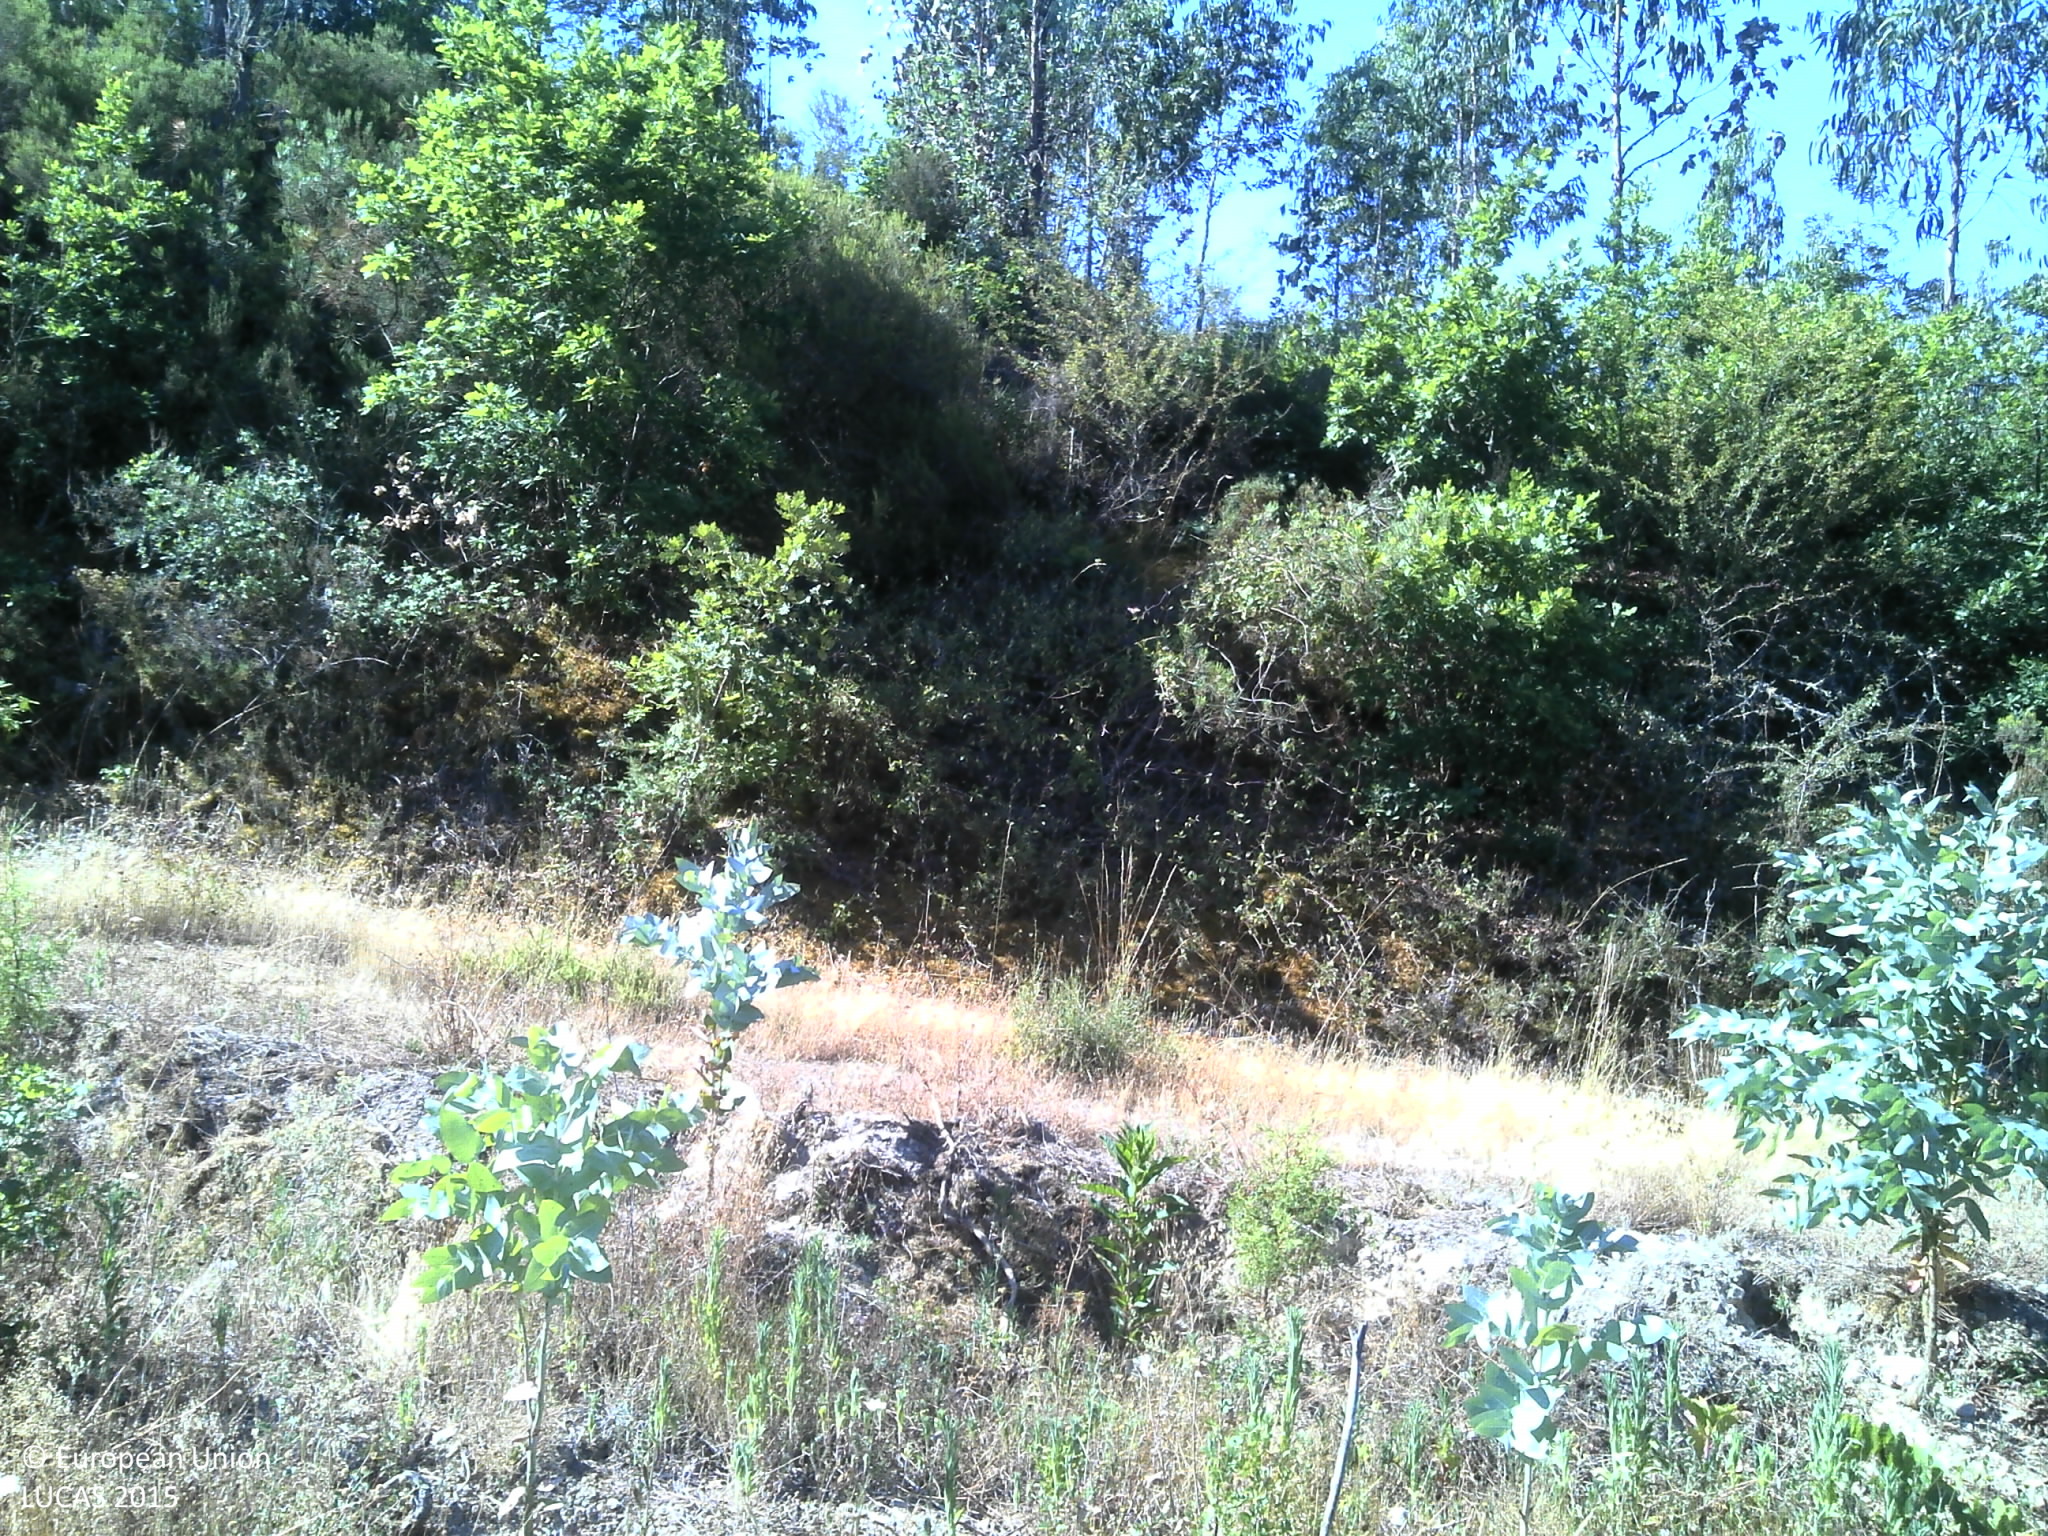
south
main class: Woodland
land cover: Broadleaved woodland
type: exotic forest
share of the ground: 10 - 25 %
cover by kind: unconsolidated bare surface 50 %, broadleaved forest trees 25 %, shrubs 15 %, herbaceous plants 10 %
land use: Forestry
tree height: < 5 m
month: July
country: PT
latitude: 40.2285
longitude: -8.1154
